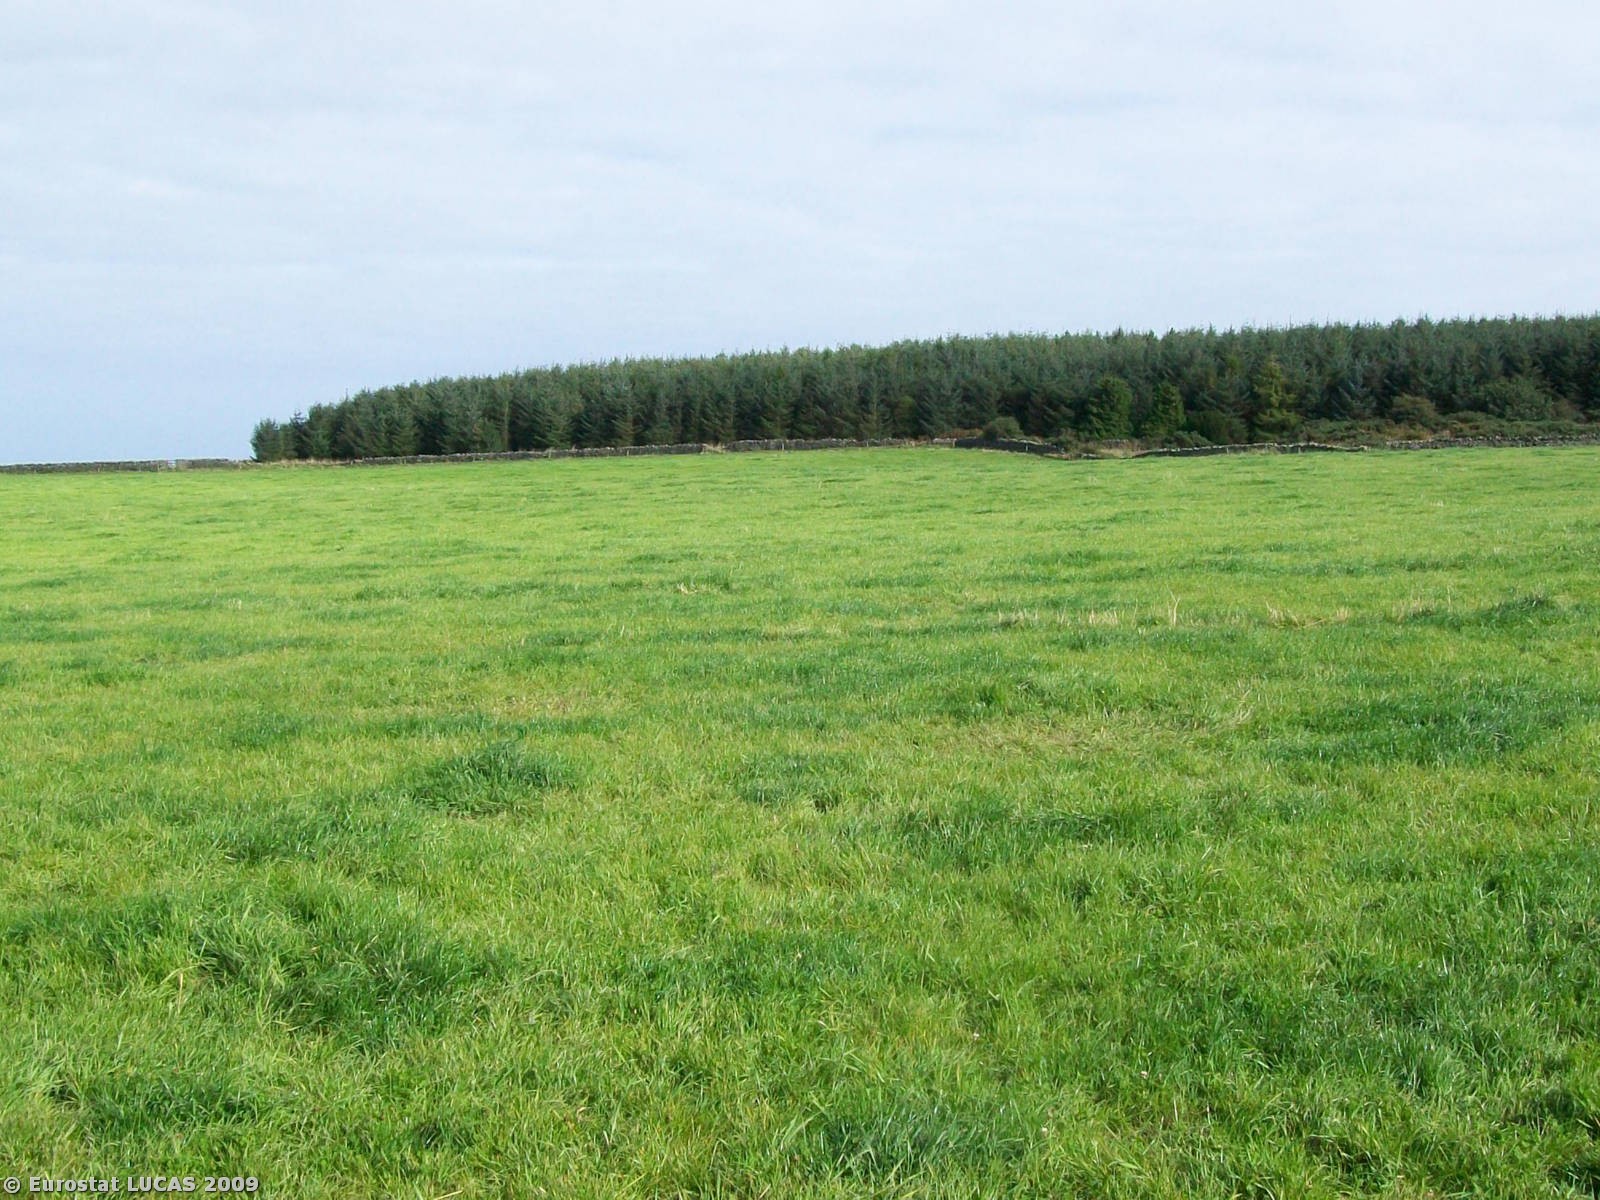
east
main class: Grassland
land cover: Grassland without tree/shrub cover
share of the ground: > 75 %
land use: Agriculture (excluding fallow land and kitchen gardens)
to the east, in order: Grassland without tree/shrub cover; Dry stone walls; Grass margins
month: September
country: GB
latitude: 55.6478
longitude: -1.9215
